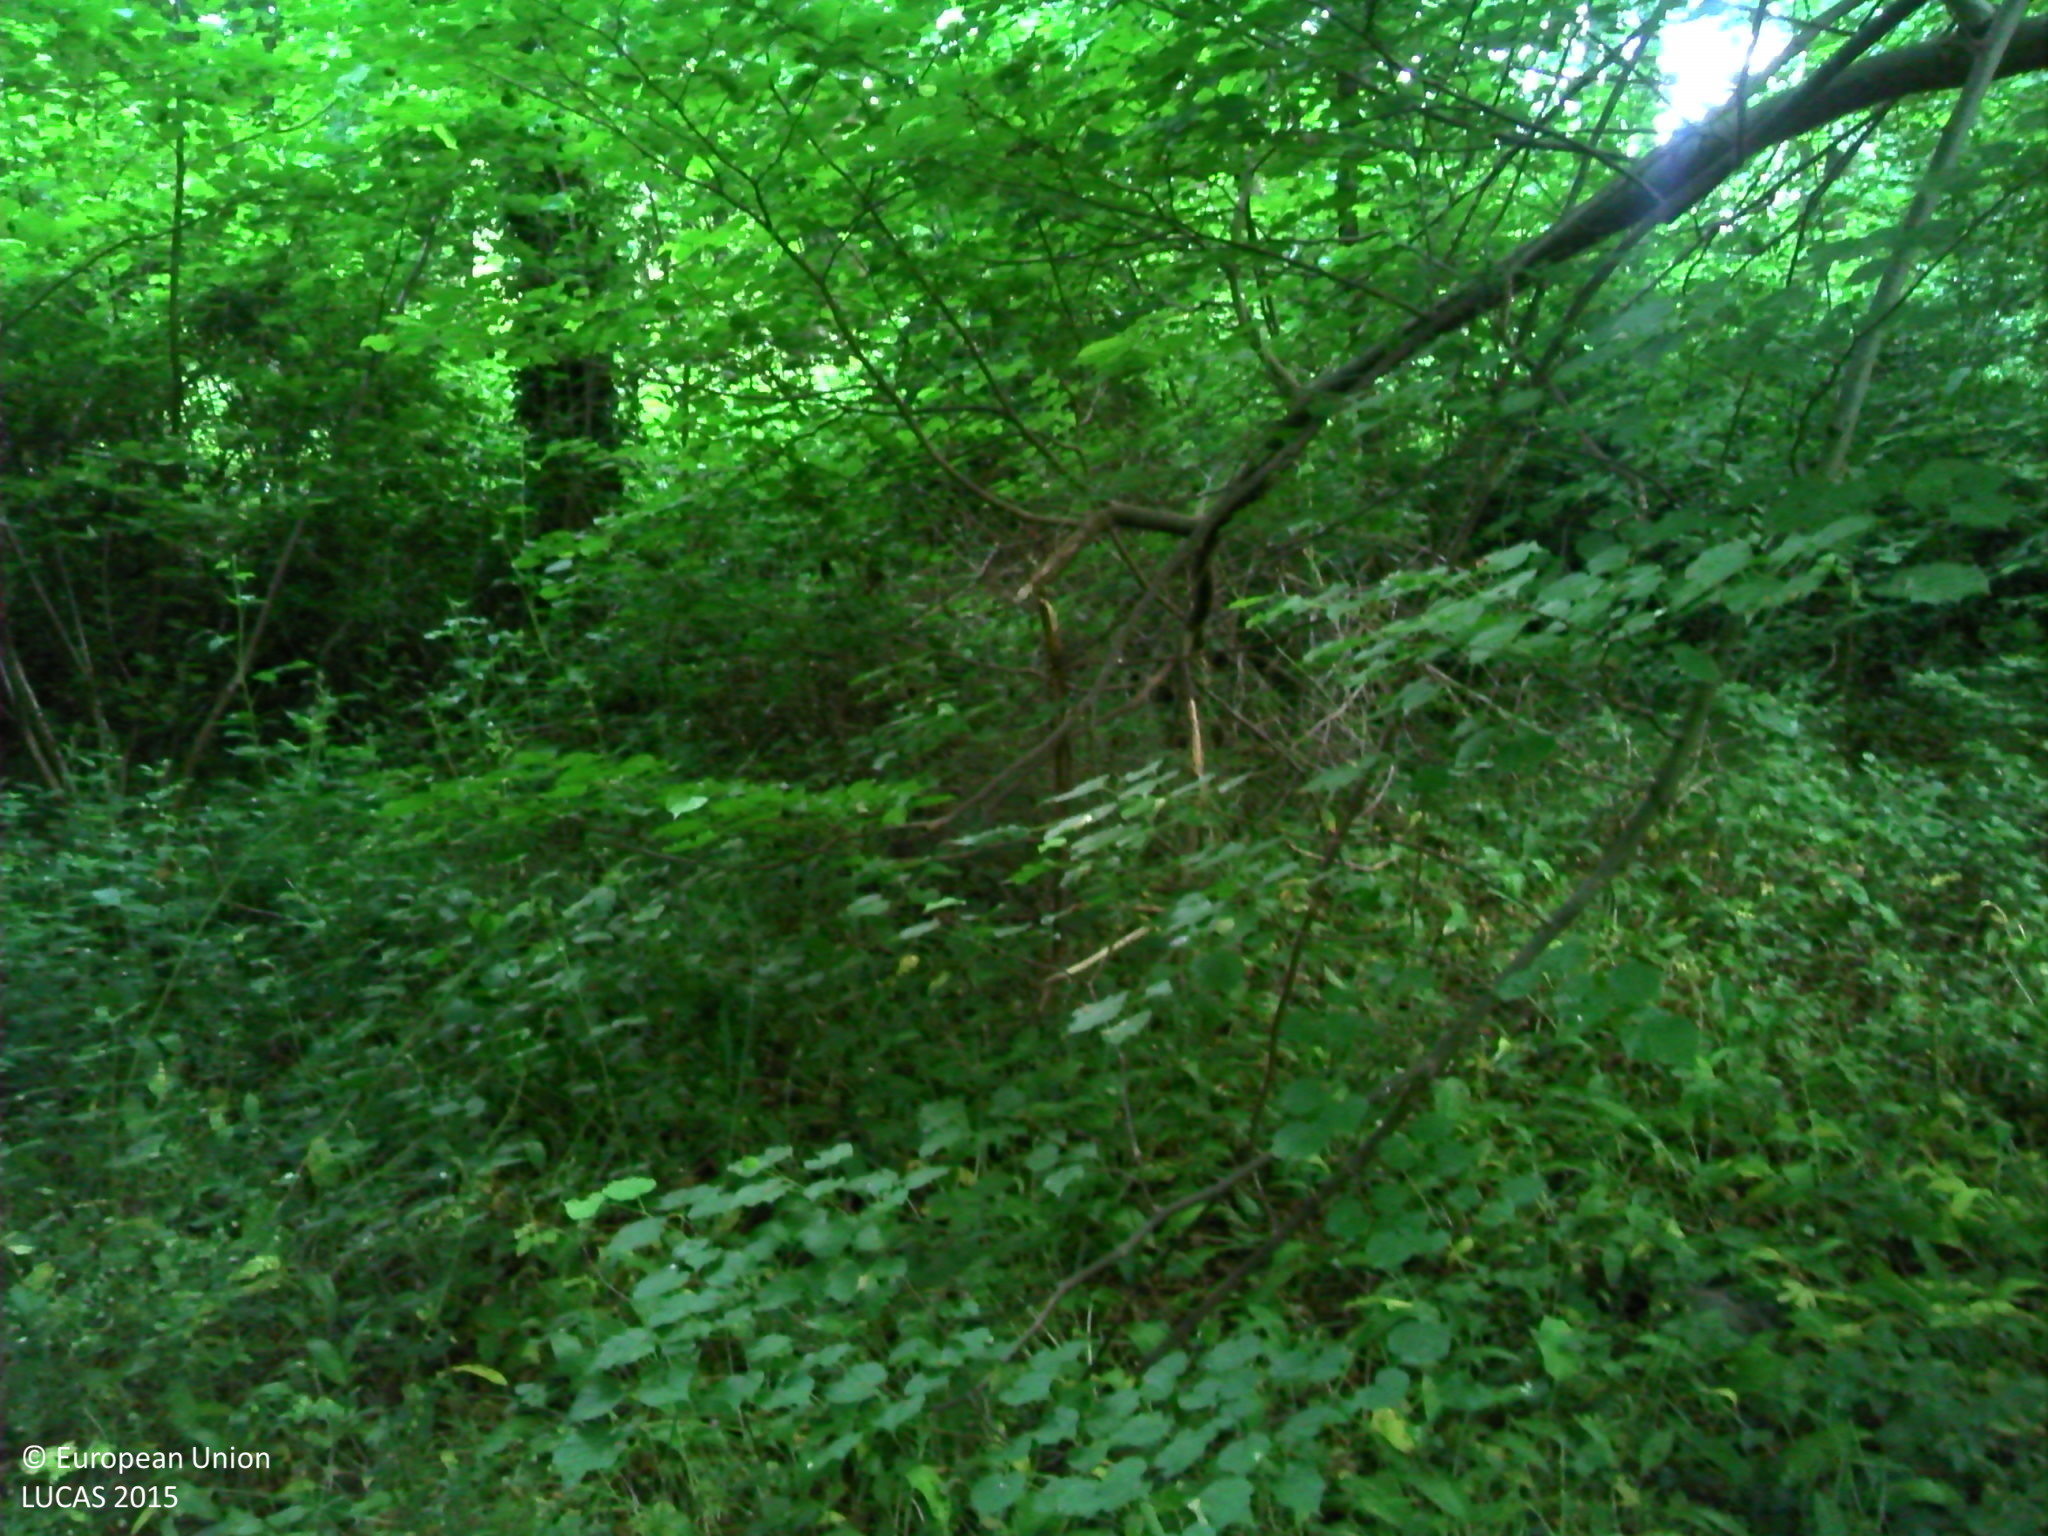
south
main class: Woodland
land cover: Broadleaved woodland
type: beech forest
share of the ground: > 75 %
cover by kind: broadleaved forest trees 100 %
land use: Forestry
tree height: > 5 m
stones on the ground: < 10 %
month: June
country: FR
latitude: 49.5533
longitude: 3.2877
